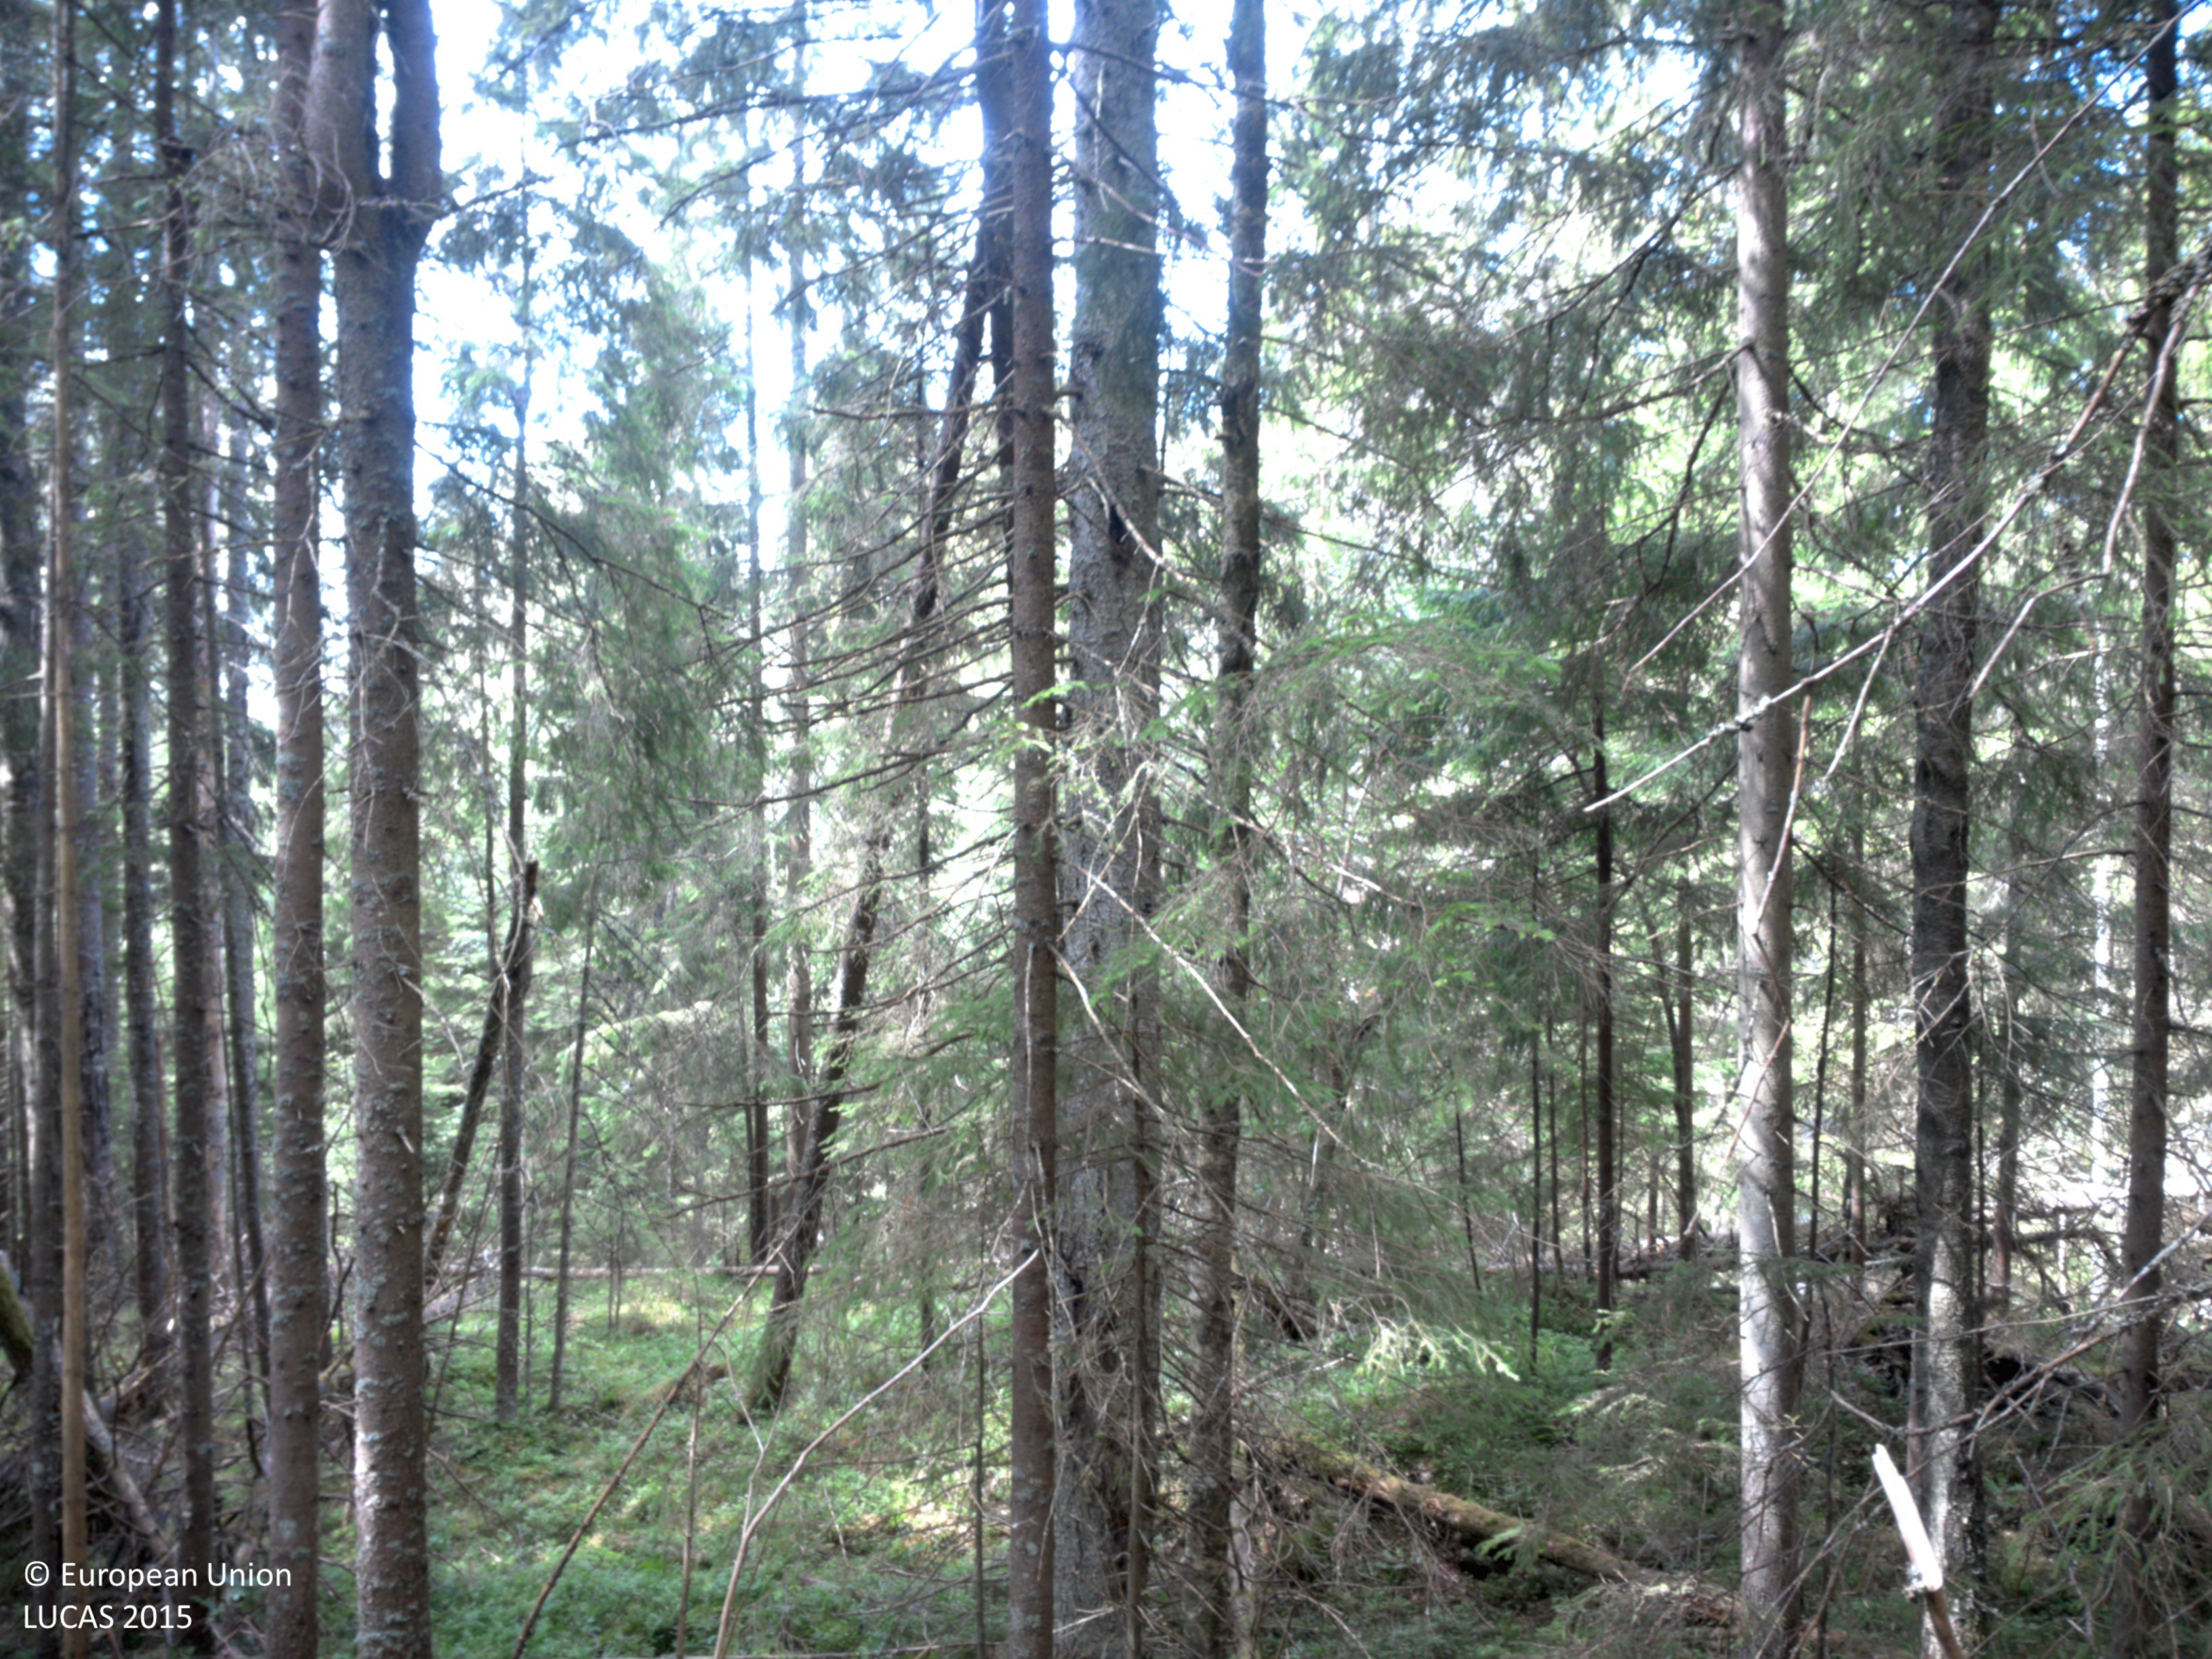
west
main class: Woodland
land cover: Spruce dominated coniferous woodland
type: boreal forest
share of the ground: 50 - 75 %
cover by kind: coniferous forest trees 65 %, lichens and mosses 20 %, shrubs 15 %
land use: Forestry
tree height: > 5 m
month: July
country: SE
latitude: 58.7991
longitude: 11.9513
